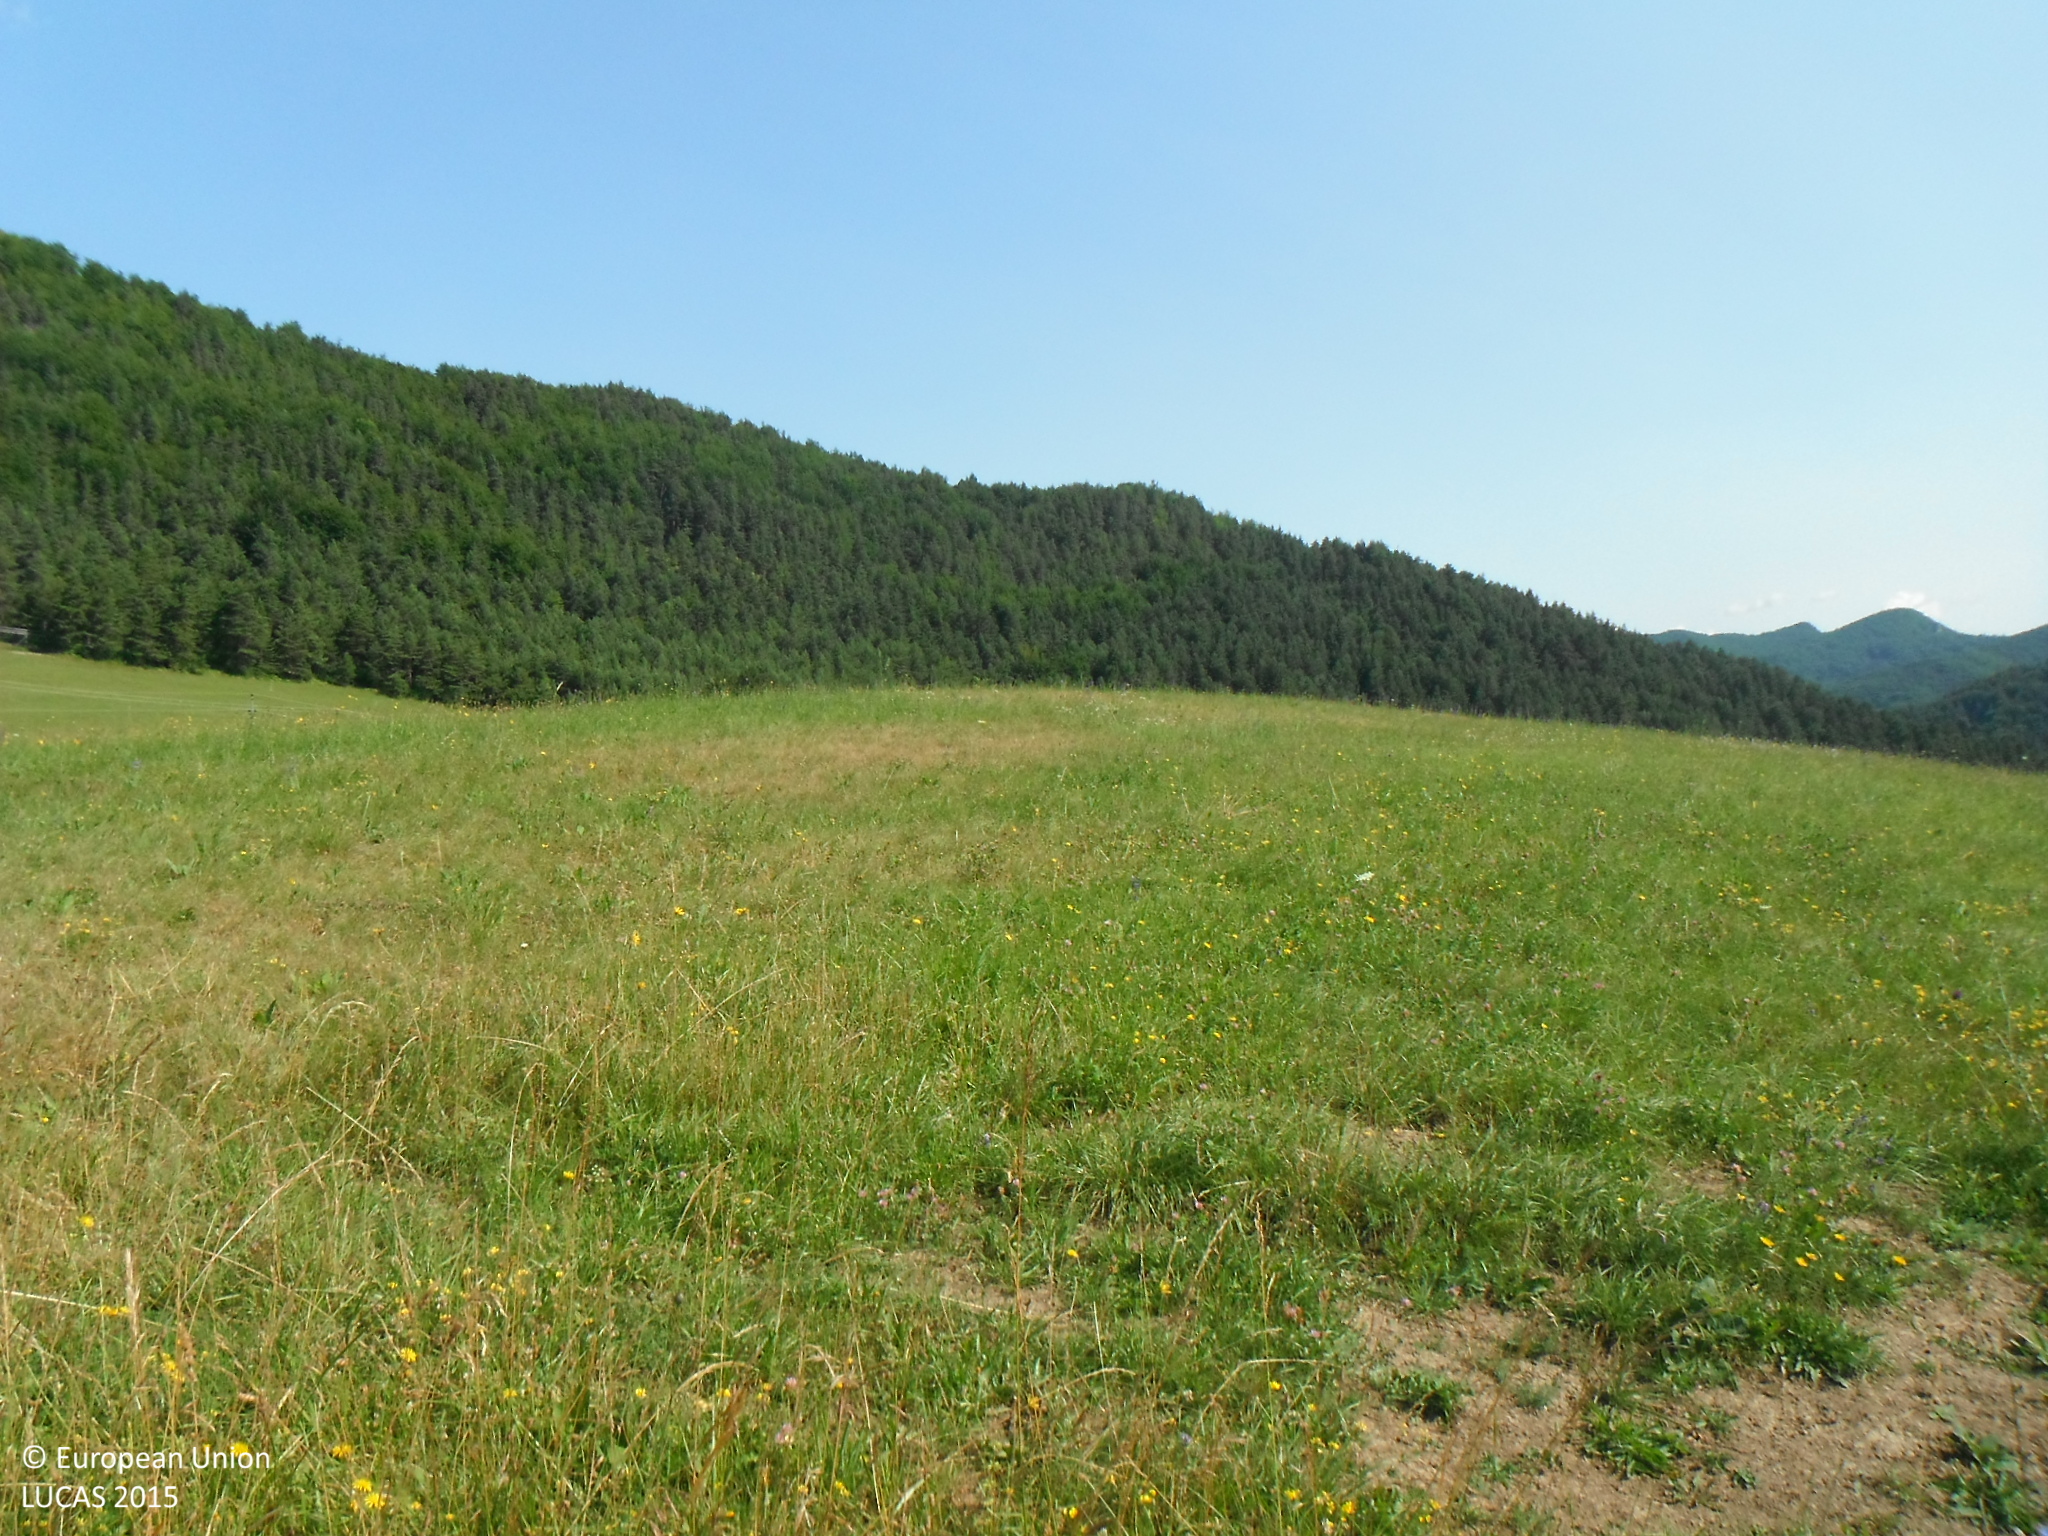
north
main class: Grassland
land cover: Grassland without tree/shrub cover
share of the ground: > 75 %
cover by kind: herbaceous plants 100 %
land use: Agriculture (excluding fallow land and kitchen gardens)
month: July
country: SK
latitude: 49.0199
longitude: 18.4545
